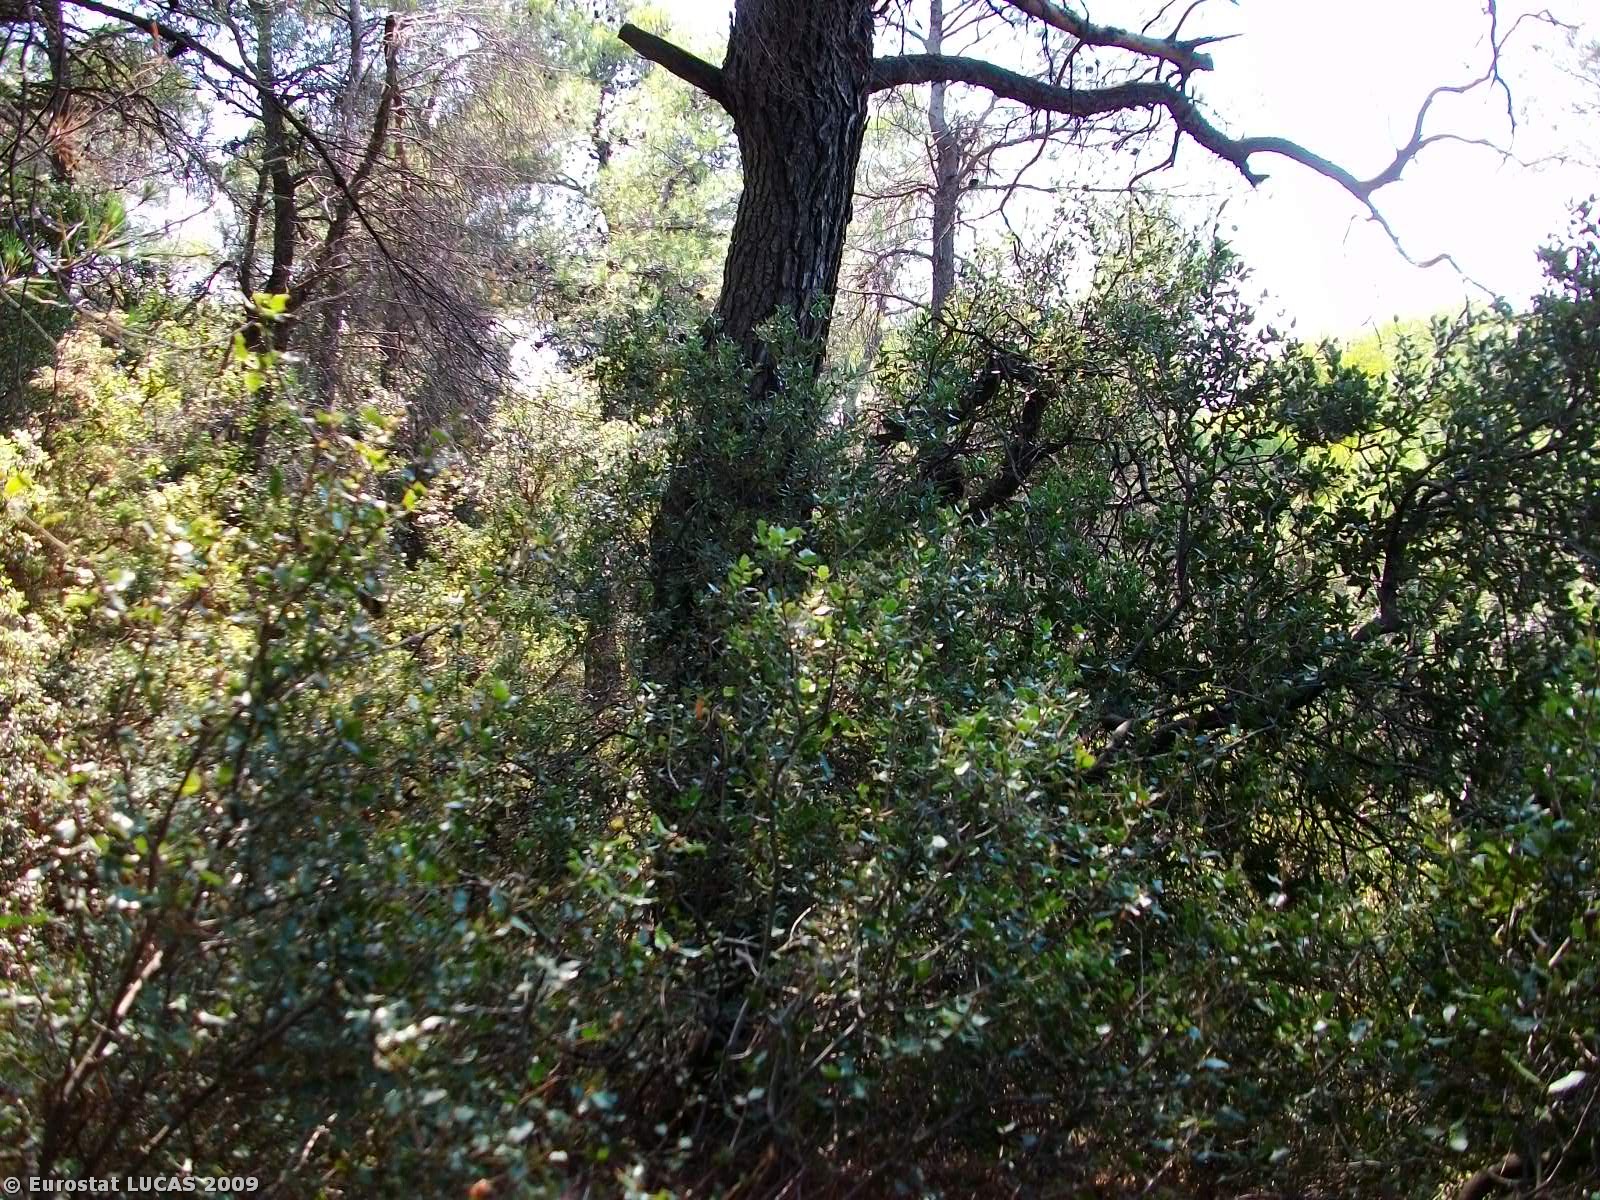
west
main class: Woodland
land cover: Coniferous woodland
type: coniferous forest of the mediterranean region
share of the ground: > 75 %
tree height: > 5 m
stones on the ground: 25 - 50 %
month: July
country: GR
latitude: 38.1737
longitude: 23.5077
